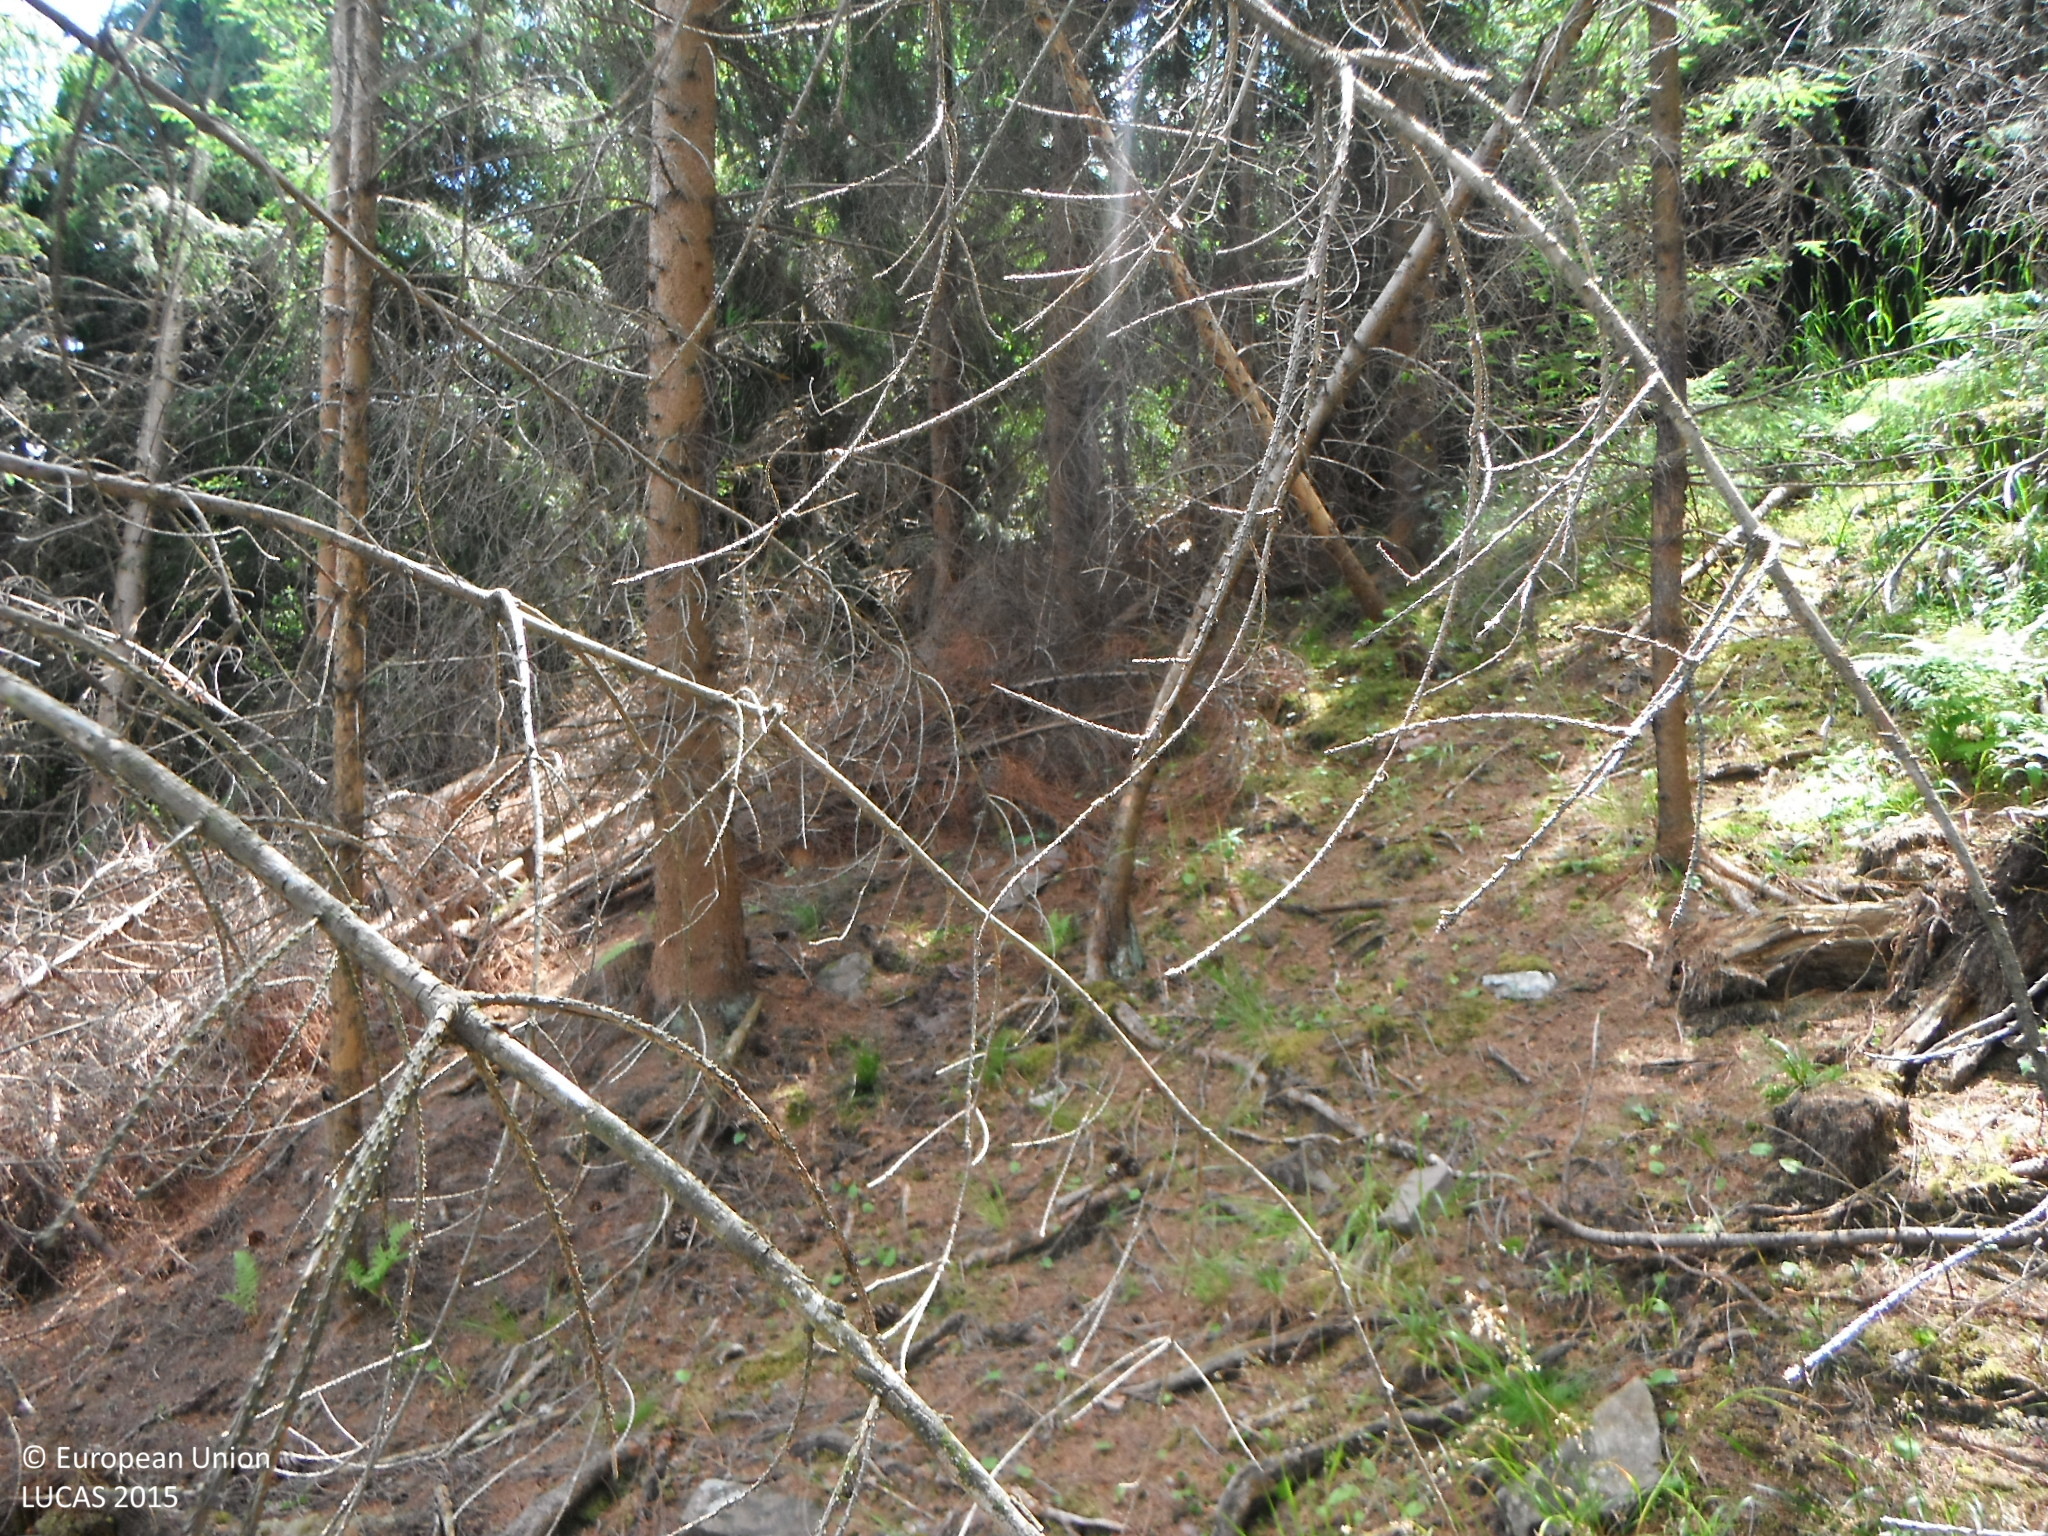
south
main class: Woodland
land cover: Spruce dominated coniferous woodland
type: alpine coniferous forest
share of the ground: > 75 %
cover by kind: coniferous forest trees 85 %, consolidated bare surface 10 %, lichens and mosses 5 %
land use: Forestry
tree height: > 5 m
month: July
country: SK
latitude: 48.9812
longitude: 20.2123
